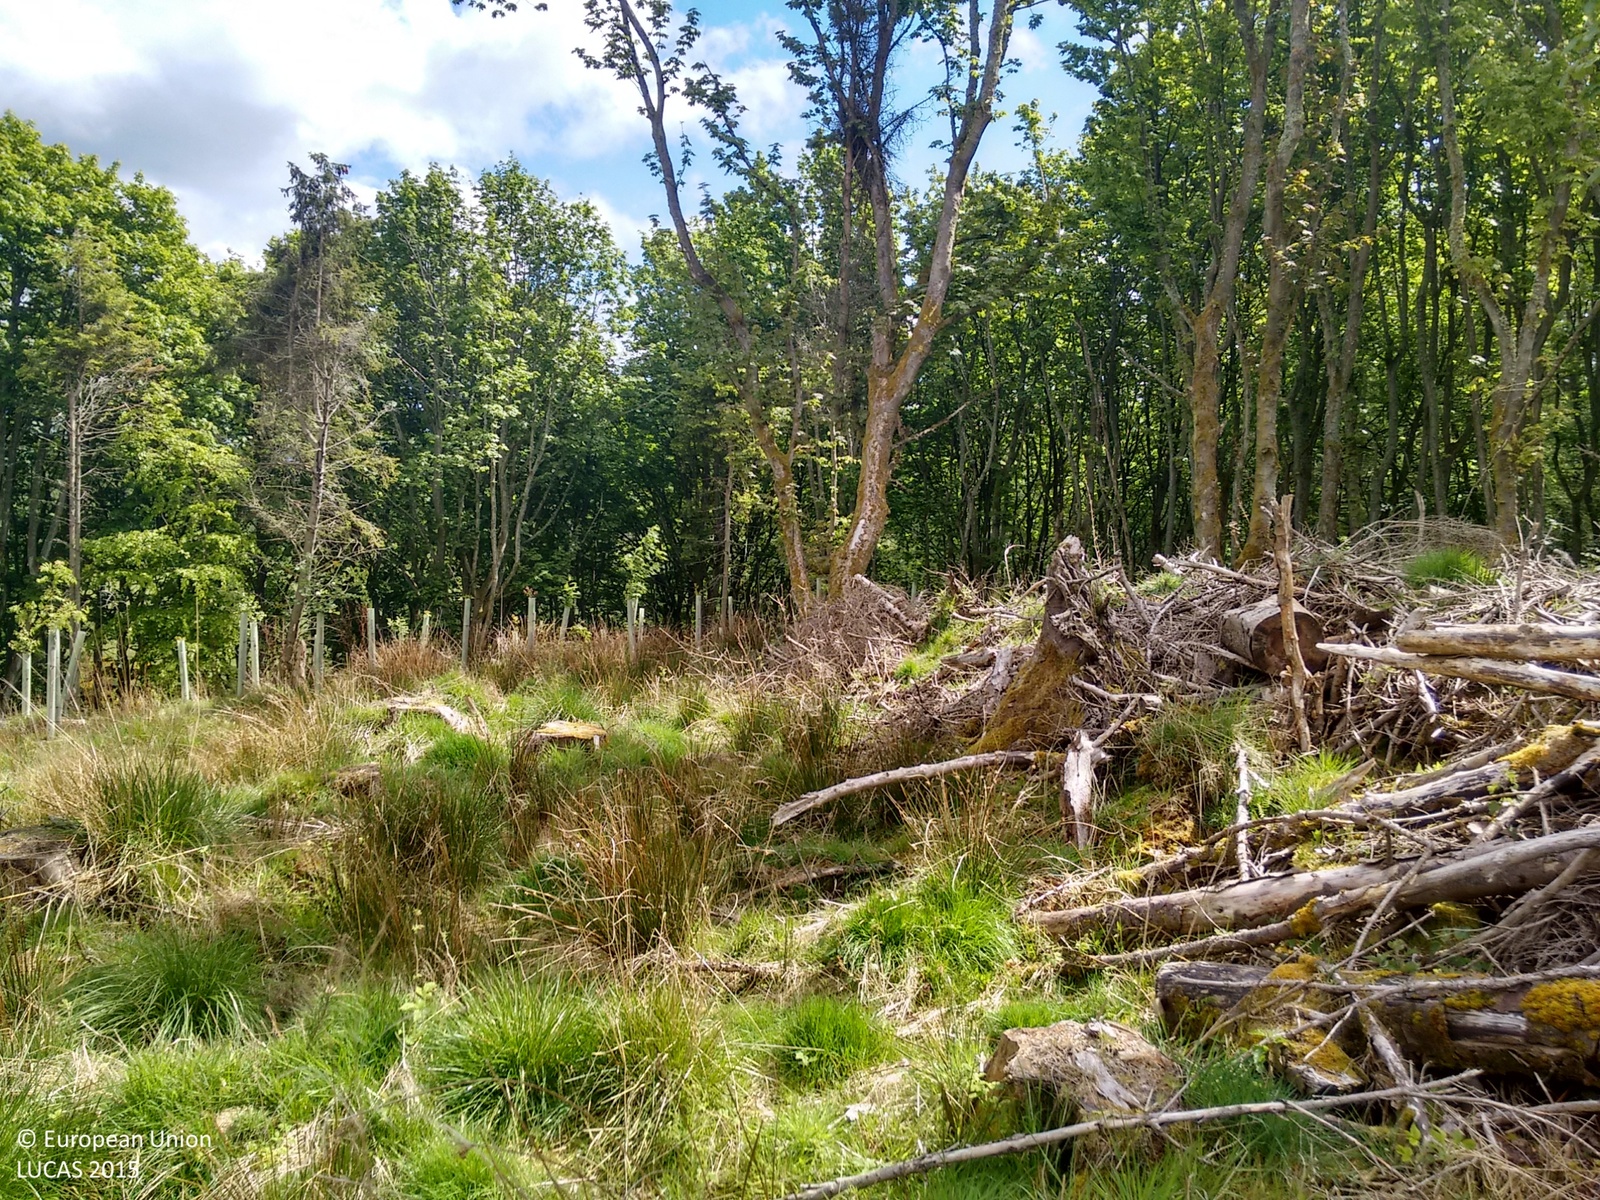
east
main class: Grassland
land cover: Grassland with sparse tree/shrub cover
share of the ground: > 75 %
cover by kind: herbaceous plants 85 %, broadleaved forest trees 5 %
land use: Forestry
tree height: > 5 m
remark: Clear cut
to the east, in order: Grassland with sparse tree/shrub cover; Broadleaved woodland; Ditches and canals; Grassland without tree/shrub cover; Fences; Grassland without tree/shrub cover
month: May
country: GB
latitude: 55.9380
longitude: -2.4985
